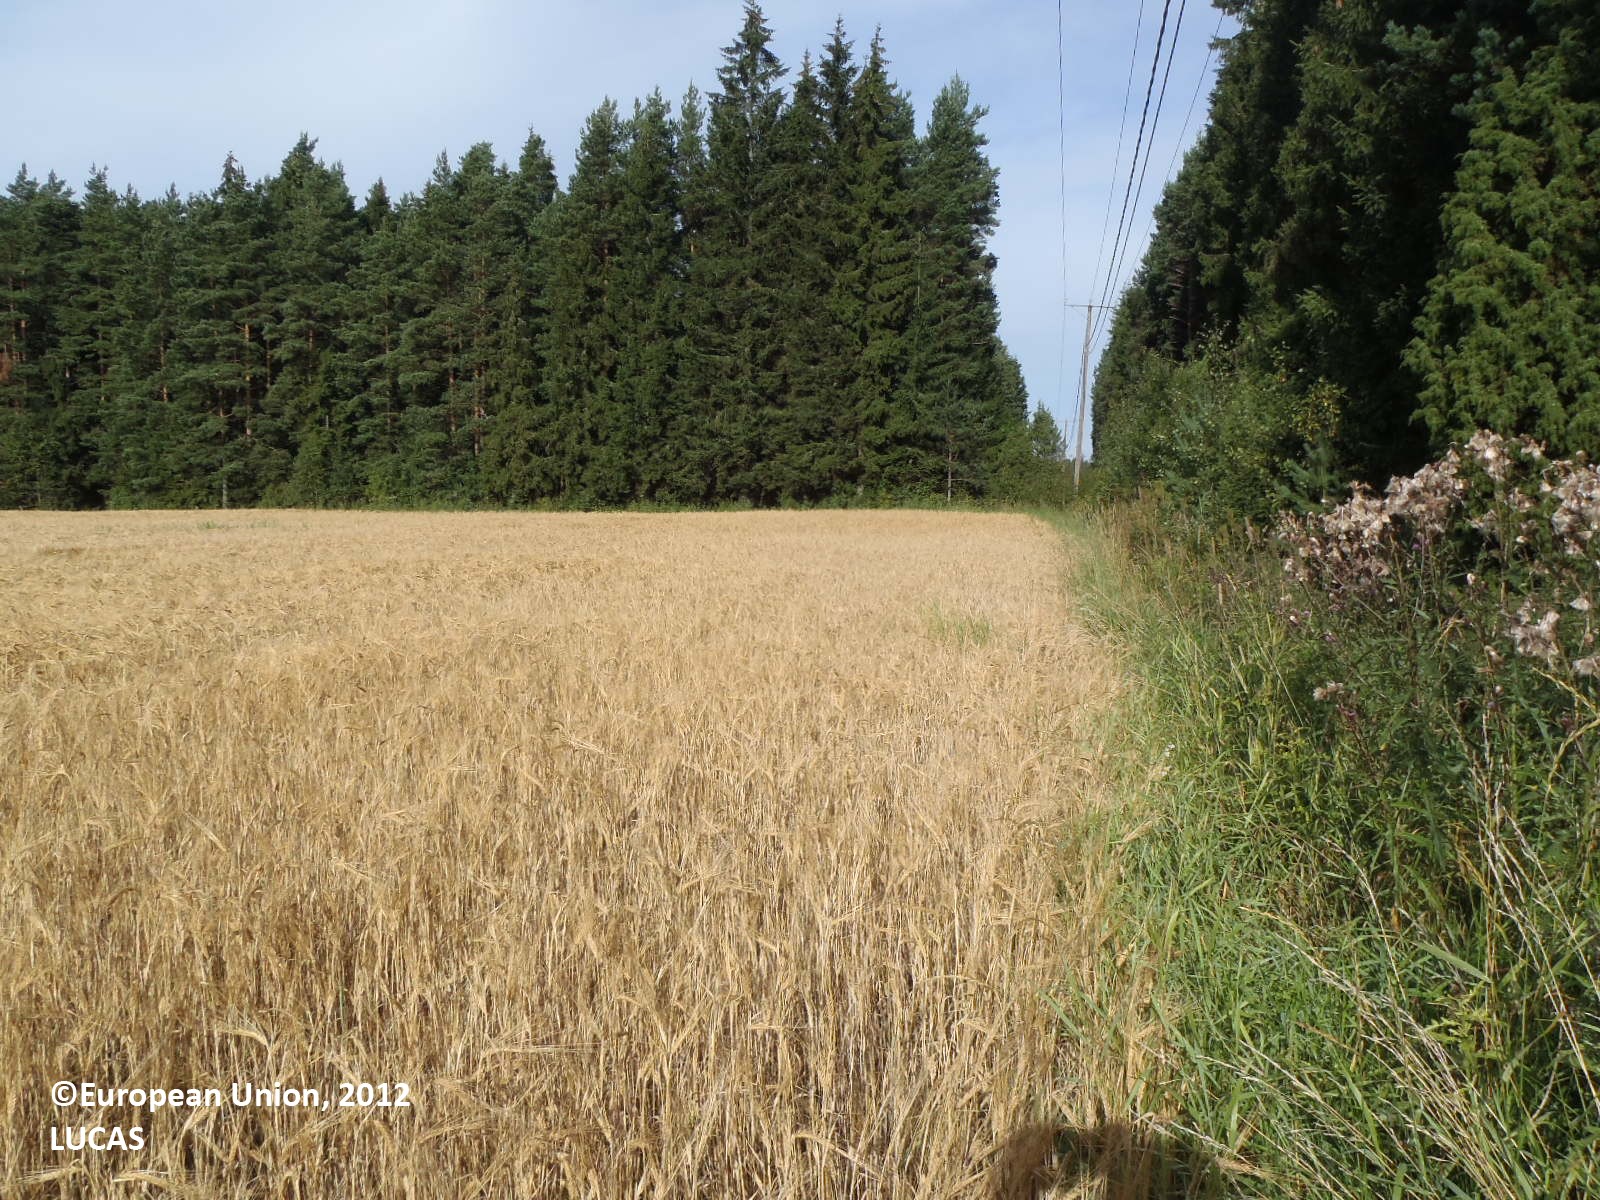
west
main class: Cropland
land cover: Barley
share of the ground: > 75 %
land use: Agriculture (excluding fallow land and kitchen gardens)
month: August
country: FI
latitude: 60.6262
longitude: 22.2934
